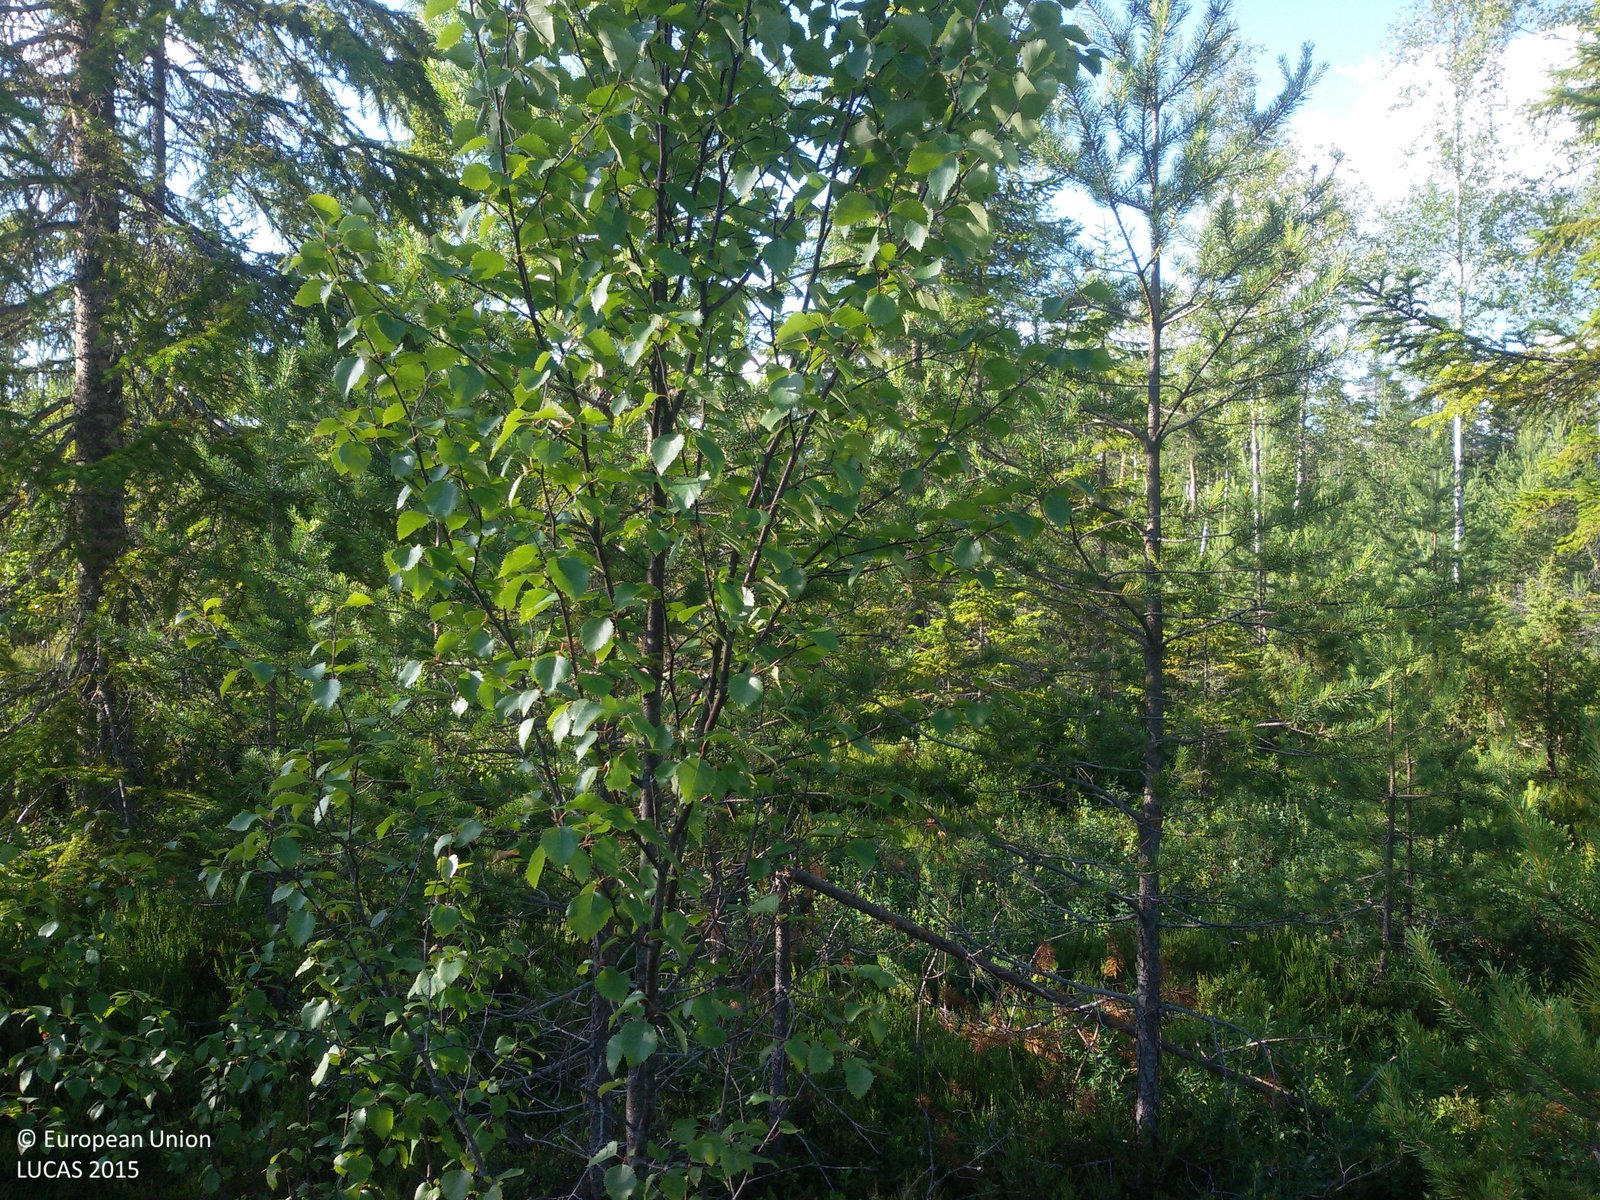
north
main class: Woodland
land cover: Pine dominated coniferous woodland
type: boreal forest
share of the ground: 50 - 75 %
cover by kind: coniferous forest trees 50 %, herbaceous plants 50 %
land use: Forestry
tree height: > 5 m
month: July
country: SE
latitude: 60.6762
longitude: 15.3138
